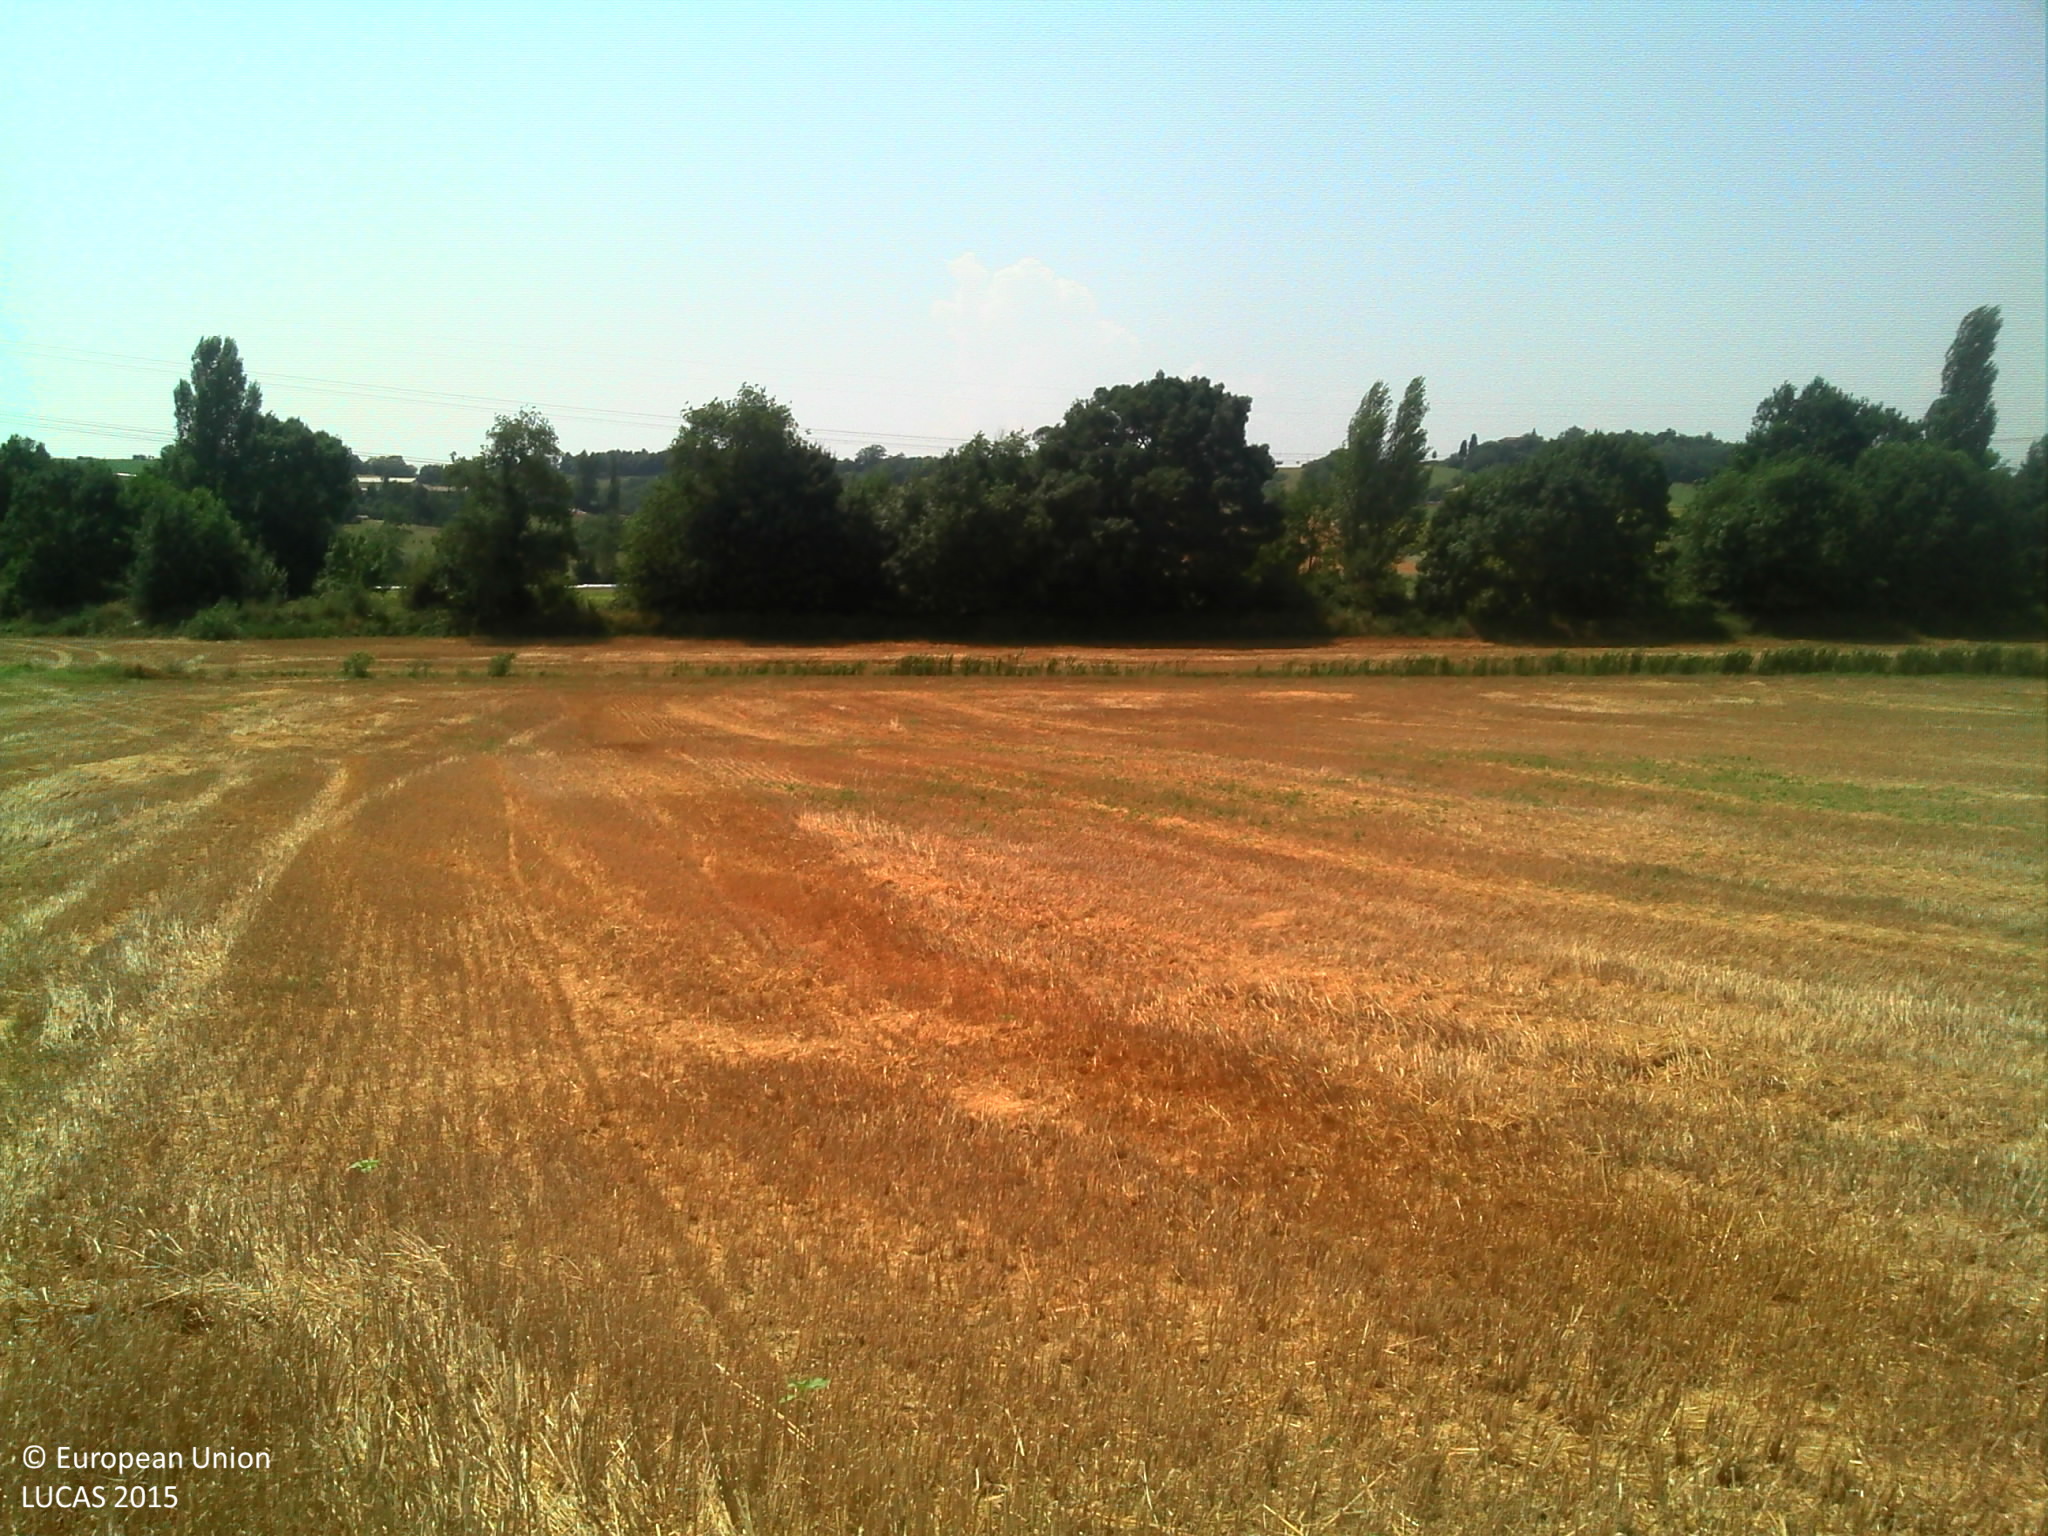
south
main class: Cropland
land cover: Barley
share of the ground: > 75 %
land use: Agriculture (excluding fallow land and kitchen gardens)
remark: Harvested field
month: July
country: FR
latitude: 43.3428
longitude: 1.0094
